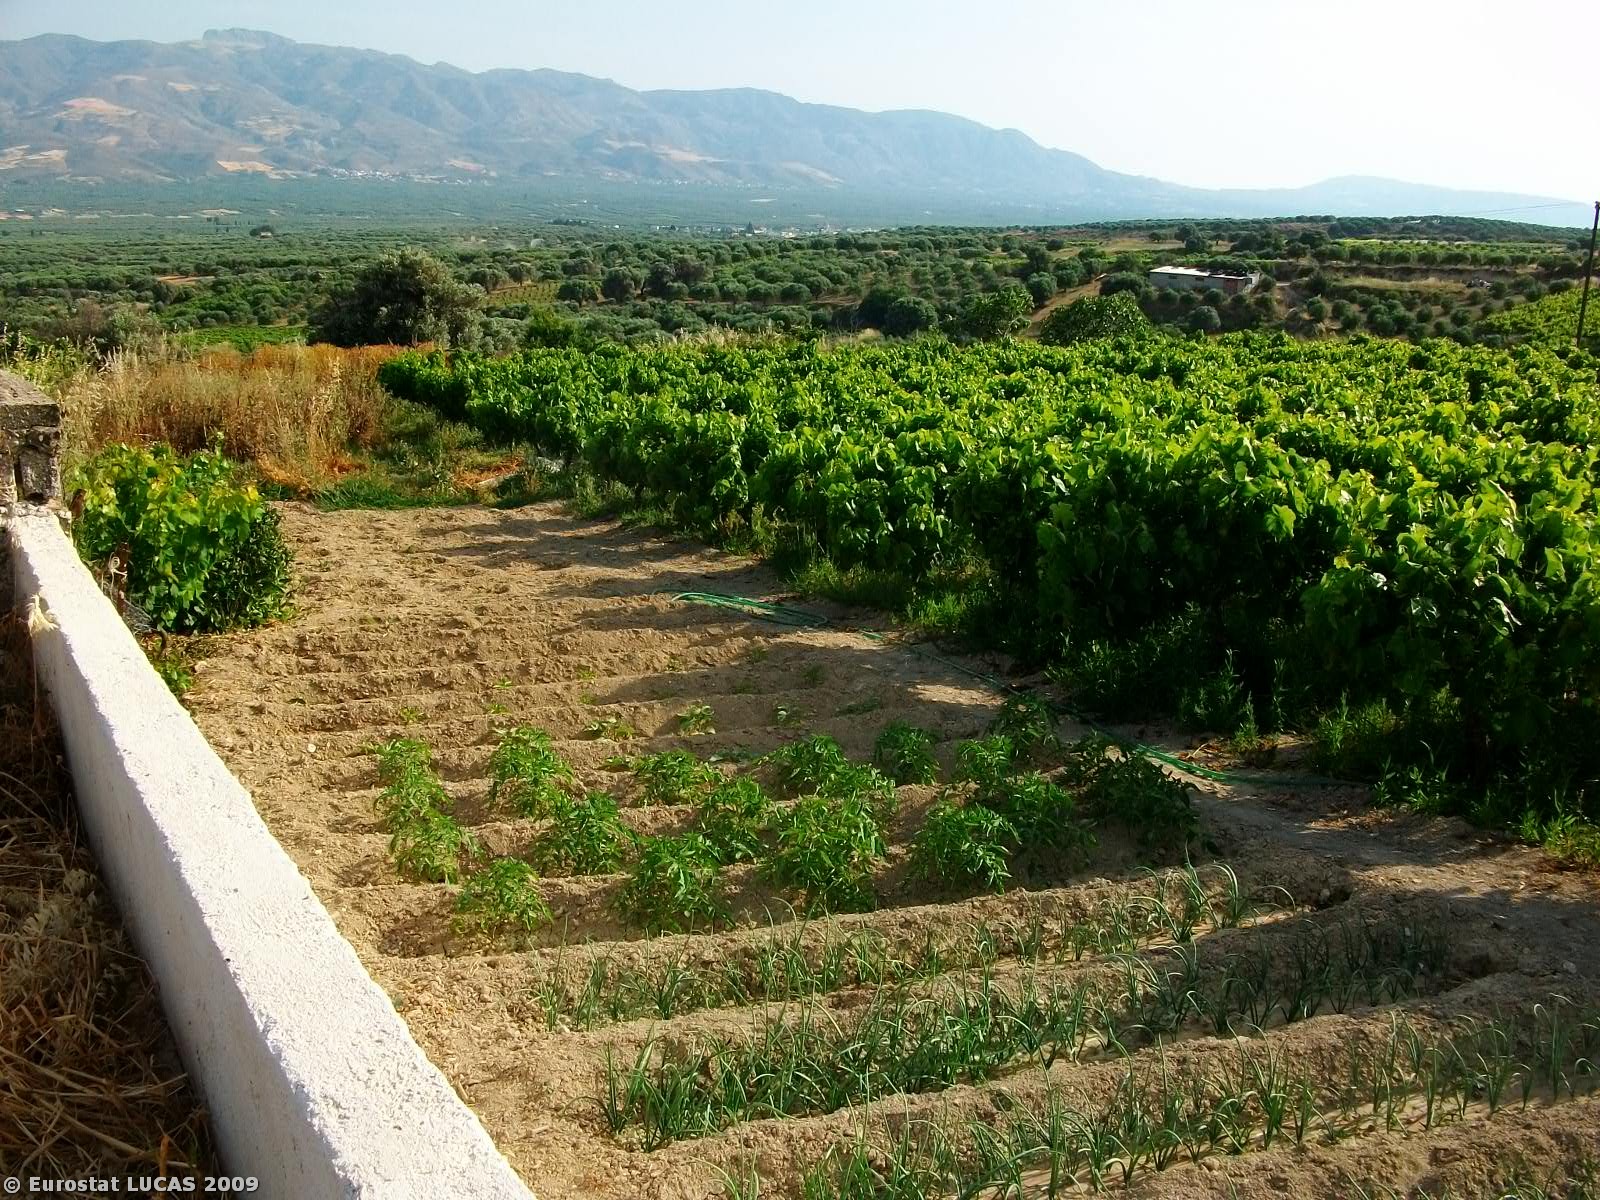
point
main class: Cropland
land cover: Vineyards
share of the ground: > 75 %
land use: Agriculture (excluding fallow land and kitchen gardens)
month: June
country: GR
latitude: 35.0586
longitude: 25.1075
